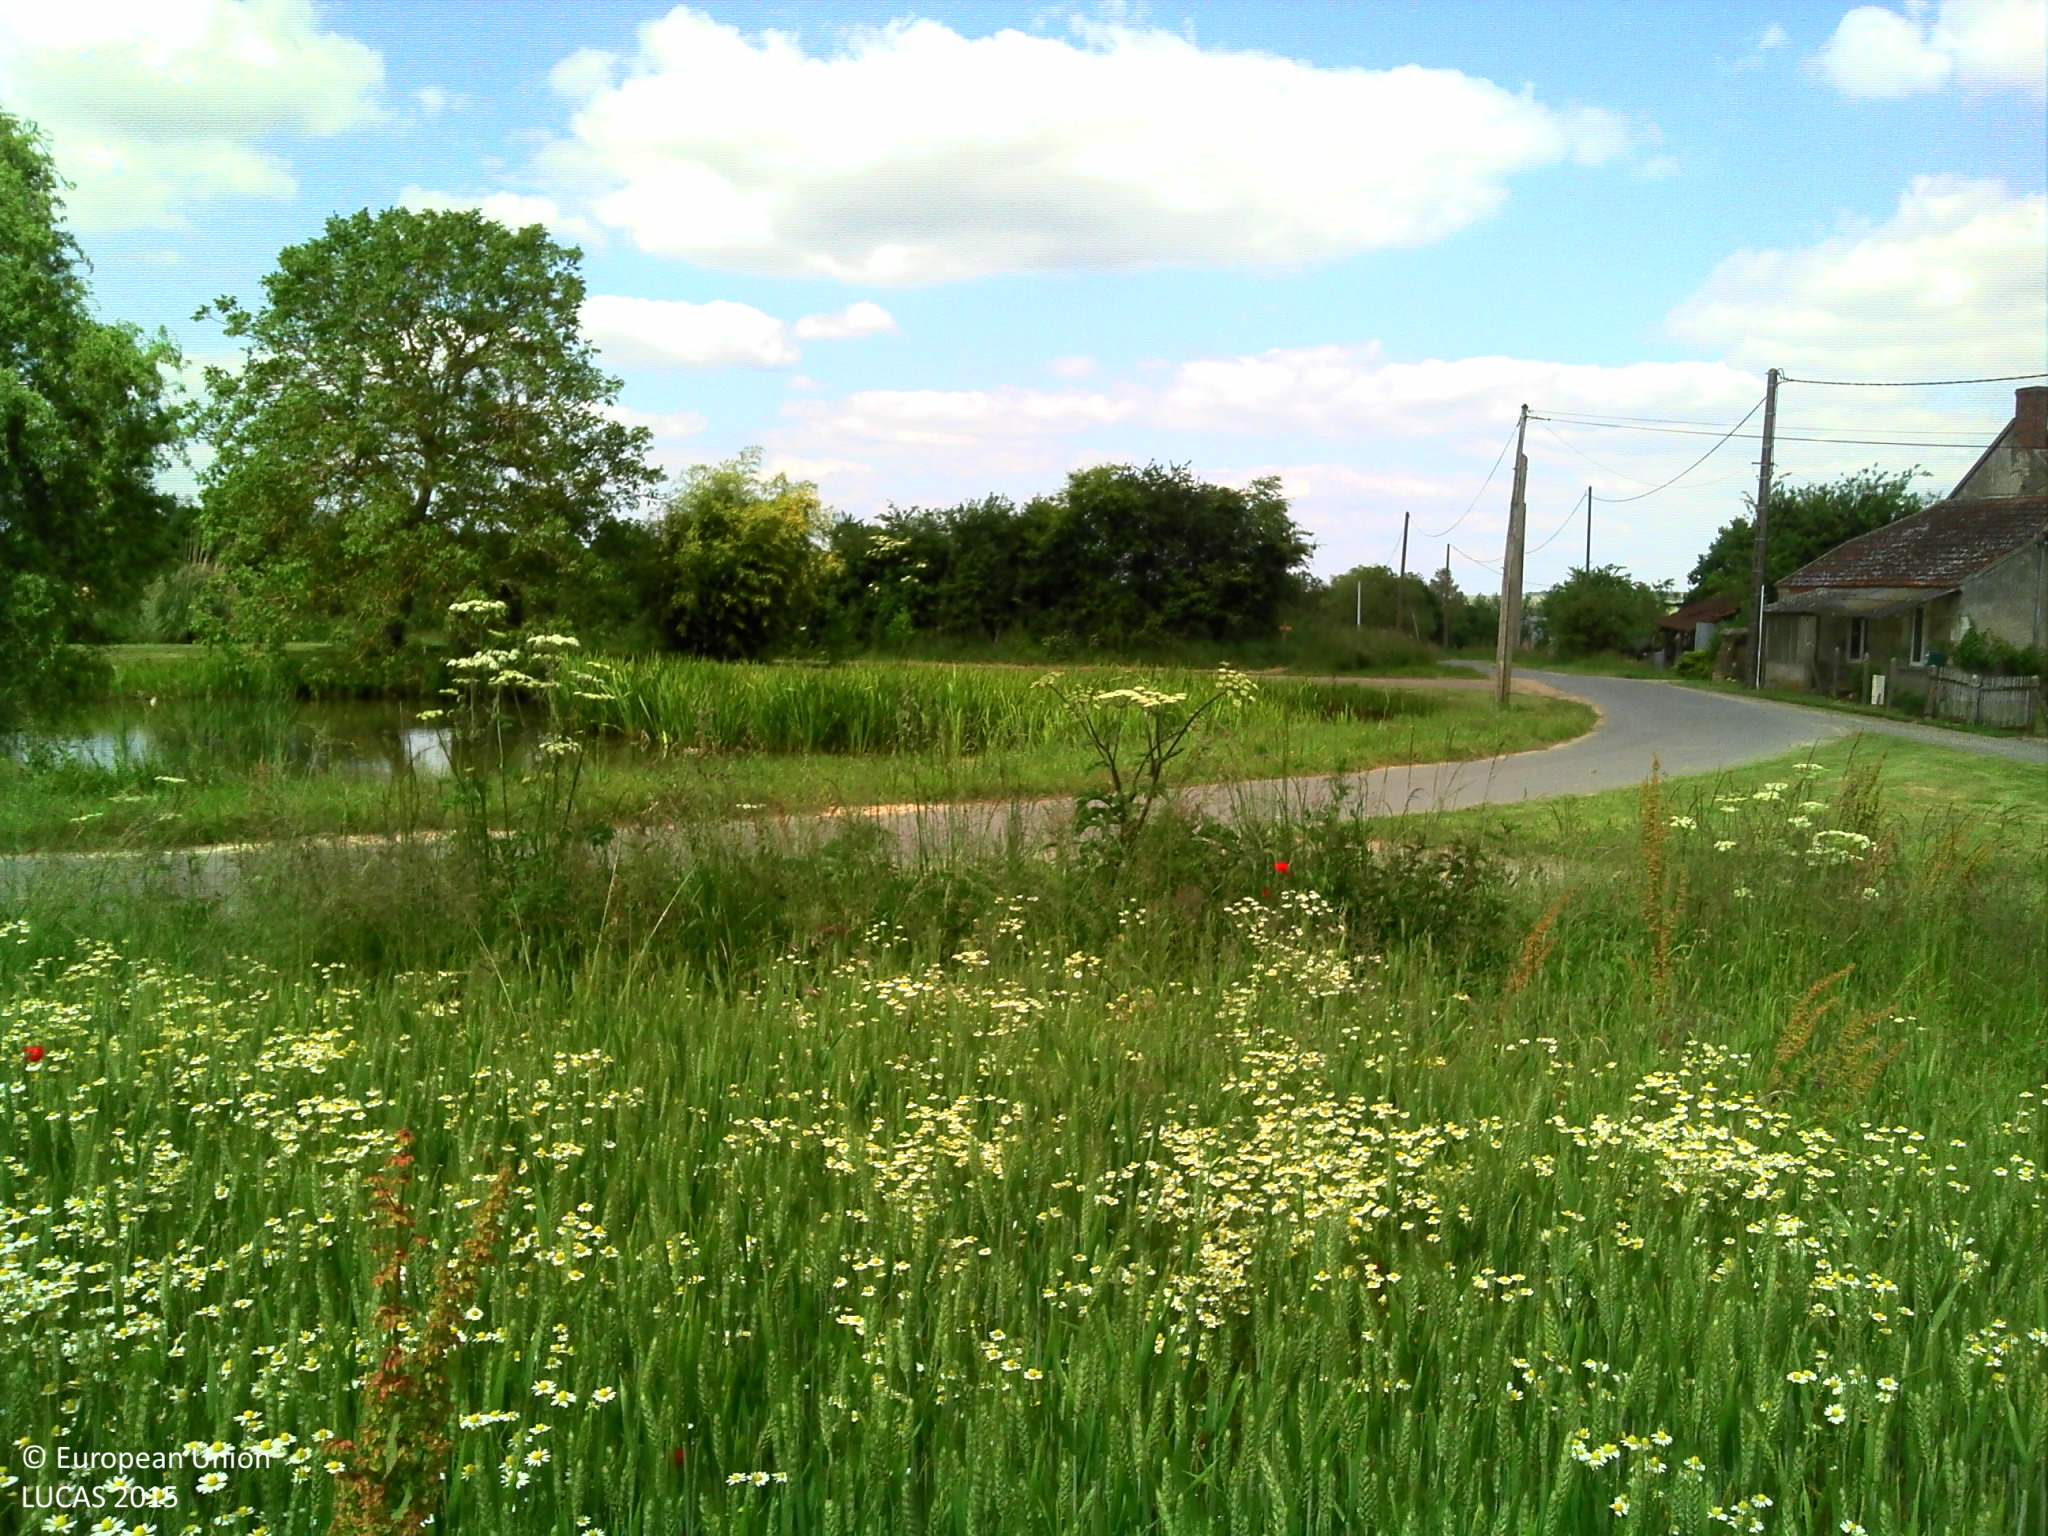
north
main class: Cropland
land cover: Common wheat
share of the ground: > 75 %
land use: Agriculture (excluding fallow land and kitchen gardens)
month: May
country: FR
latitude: 47.2554
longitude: 2.9251
